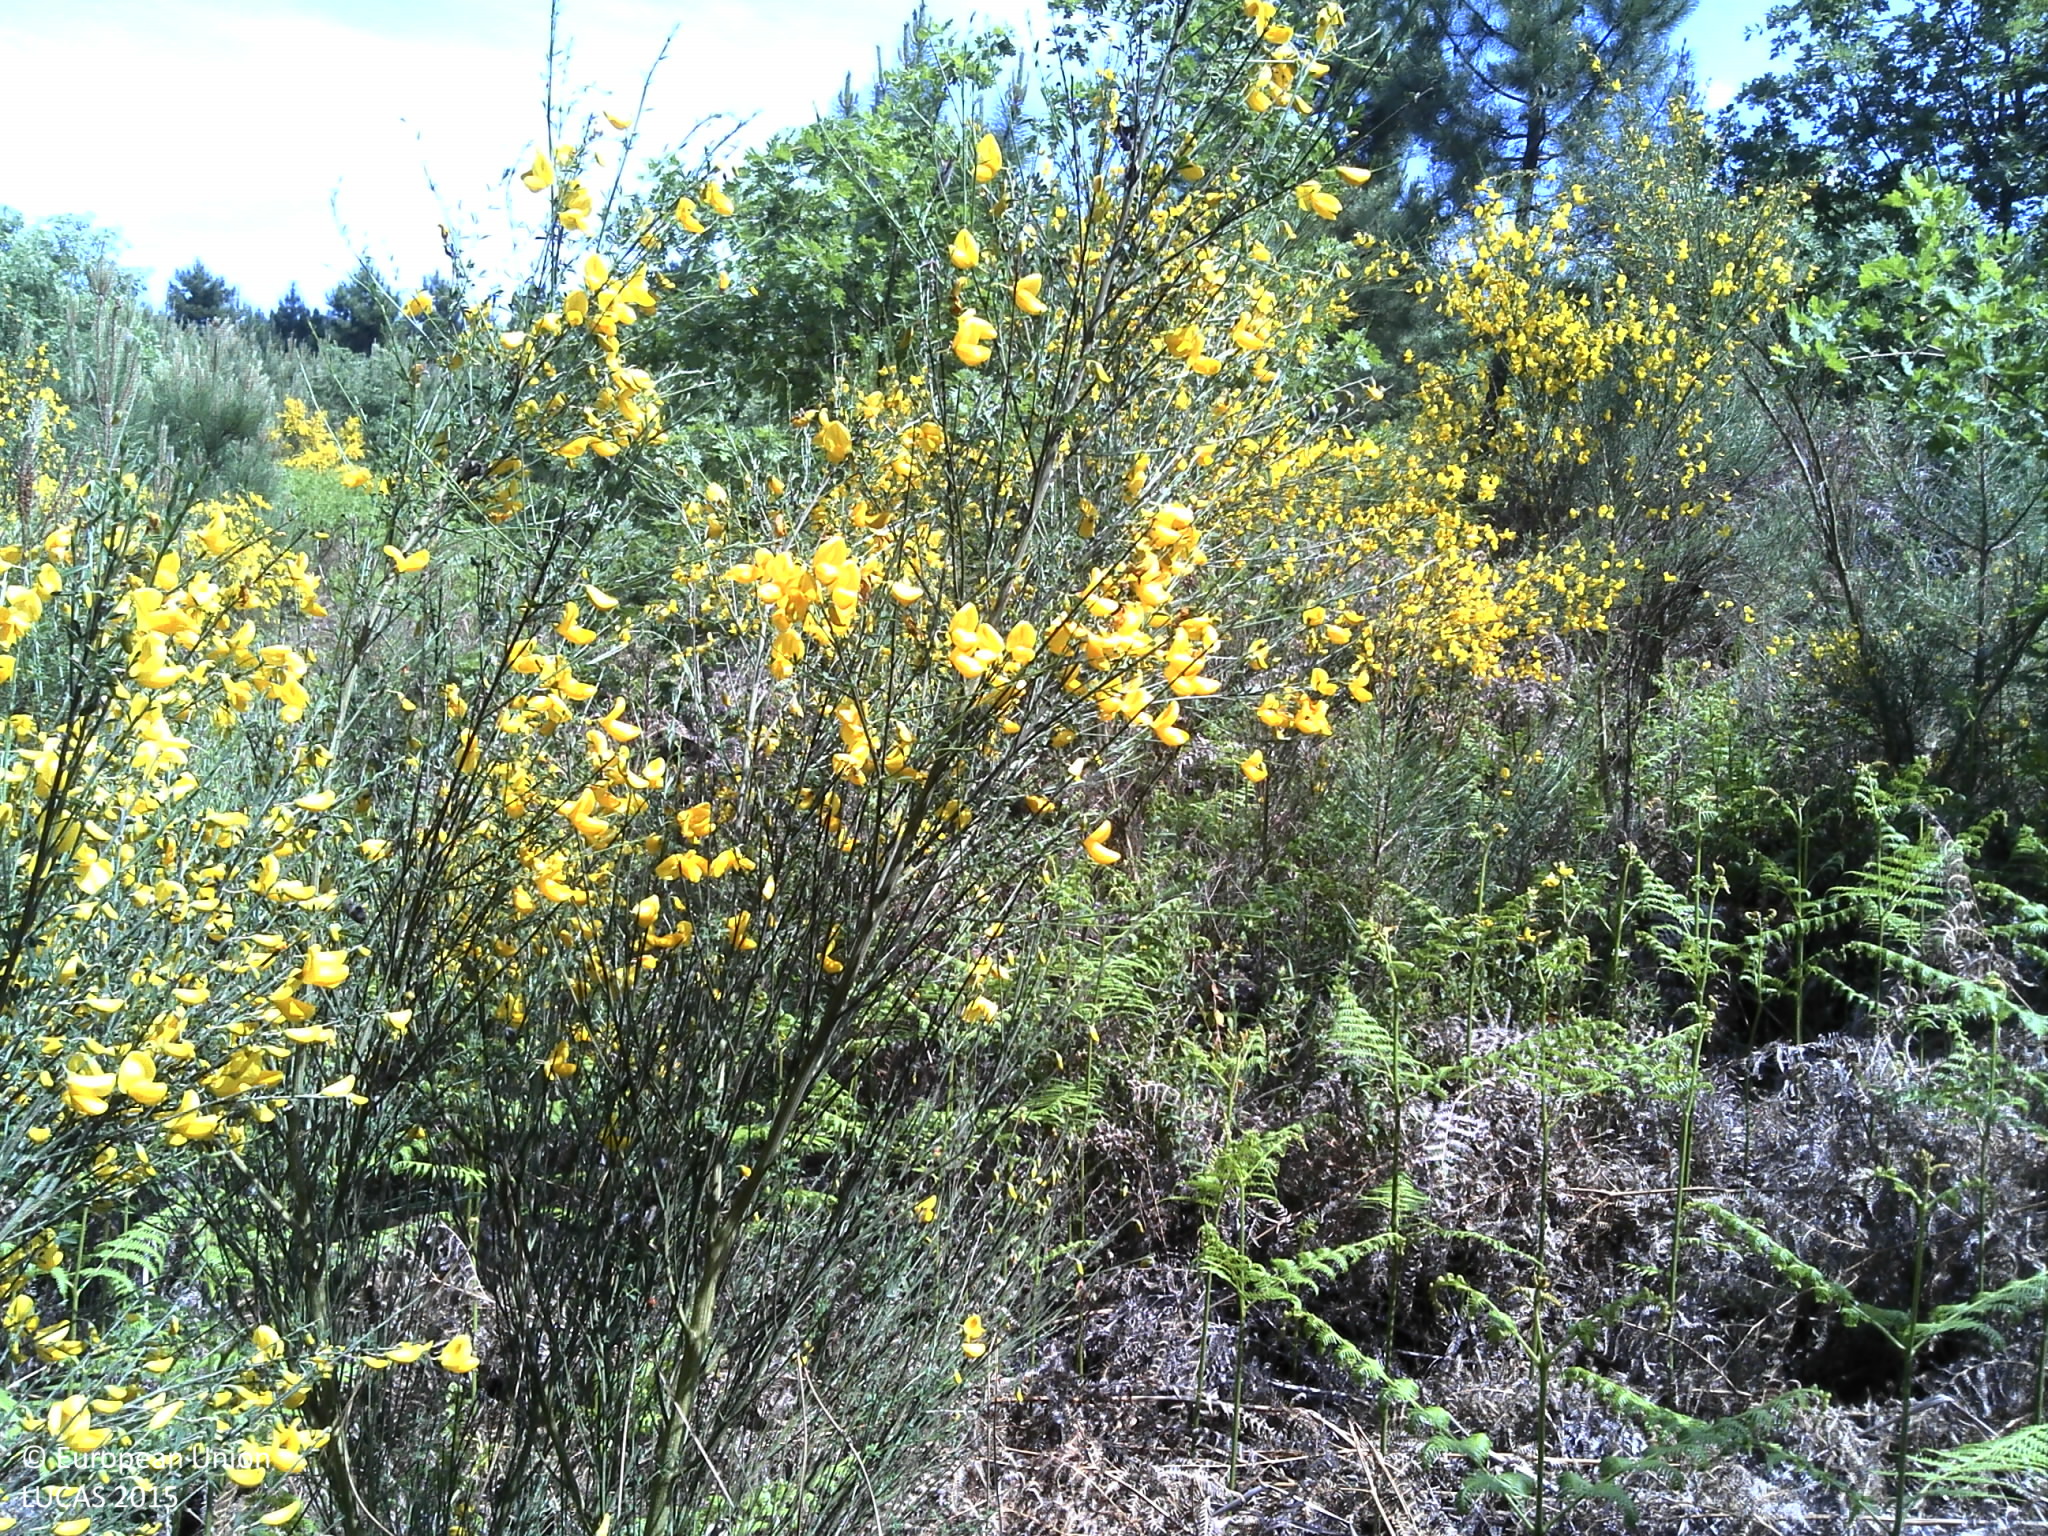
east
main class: Woodland
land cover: Pine dominated coniferous woodland
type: coniferous forest of the mediterranean region
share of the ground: 25 - 50 %
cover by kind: shrubs 60 %, coniferous forest trees 25 %, unconsolidated bare surface 15 %
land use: Forestry
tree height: < 5 m
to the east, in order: Pine dominated coniferous woodland; Shrubland with sparse tree cover; Pine dominated coniferous woodland; Tracks; Pine dominated coniferous woodland
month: May
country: PT
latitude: 41.6854
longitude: -7.5145
